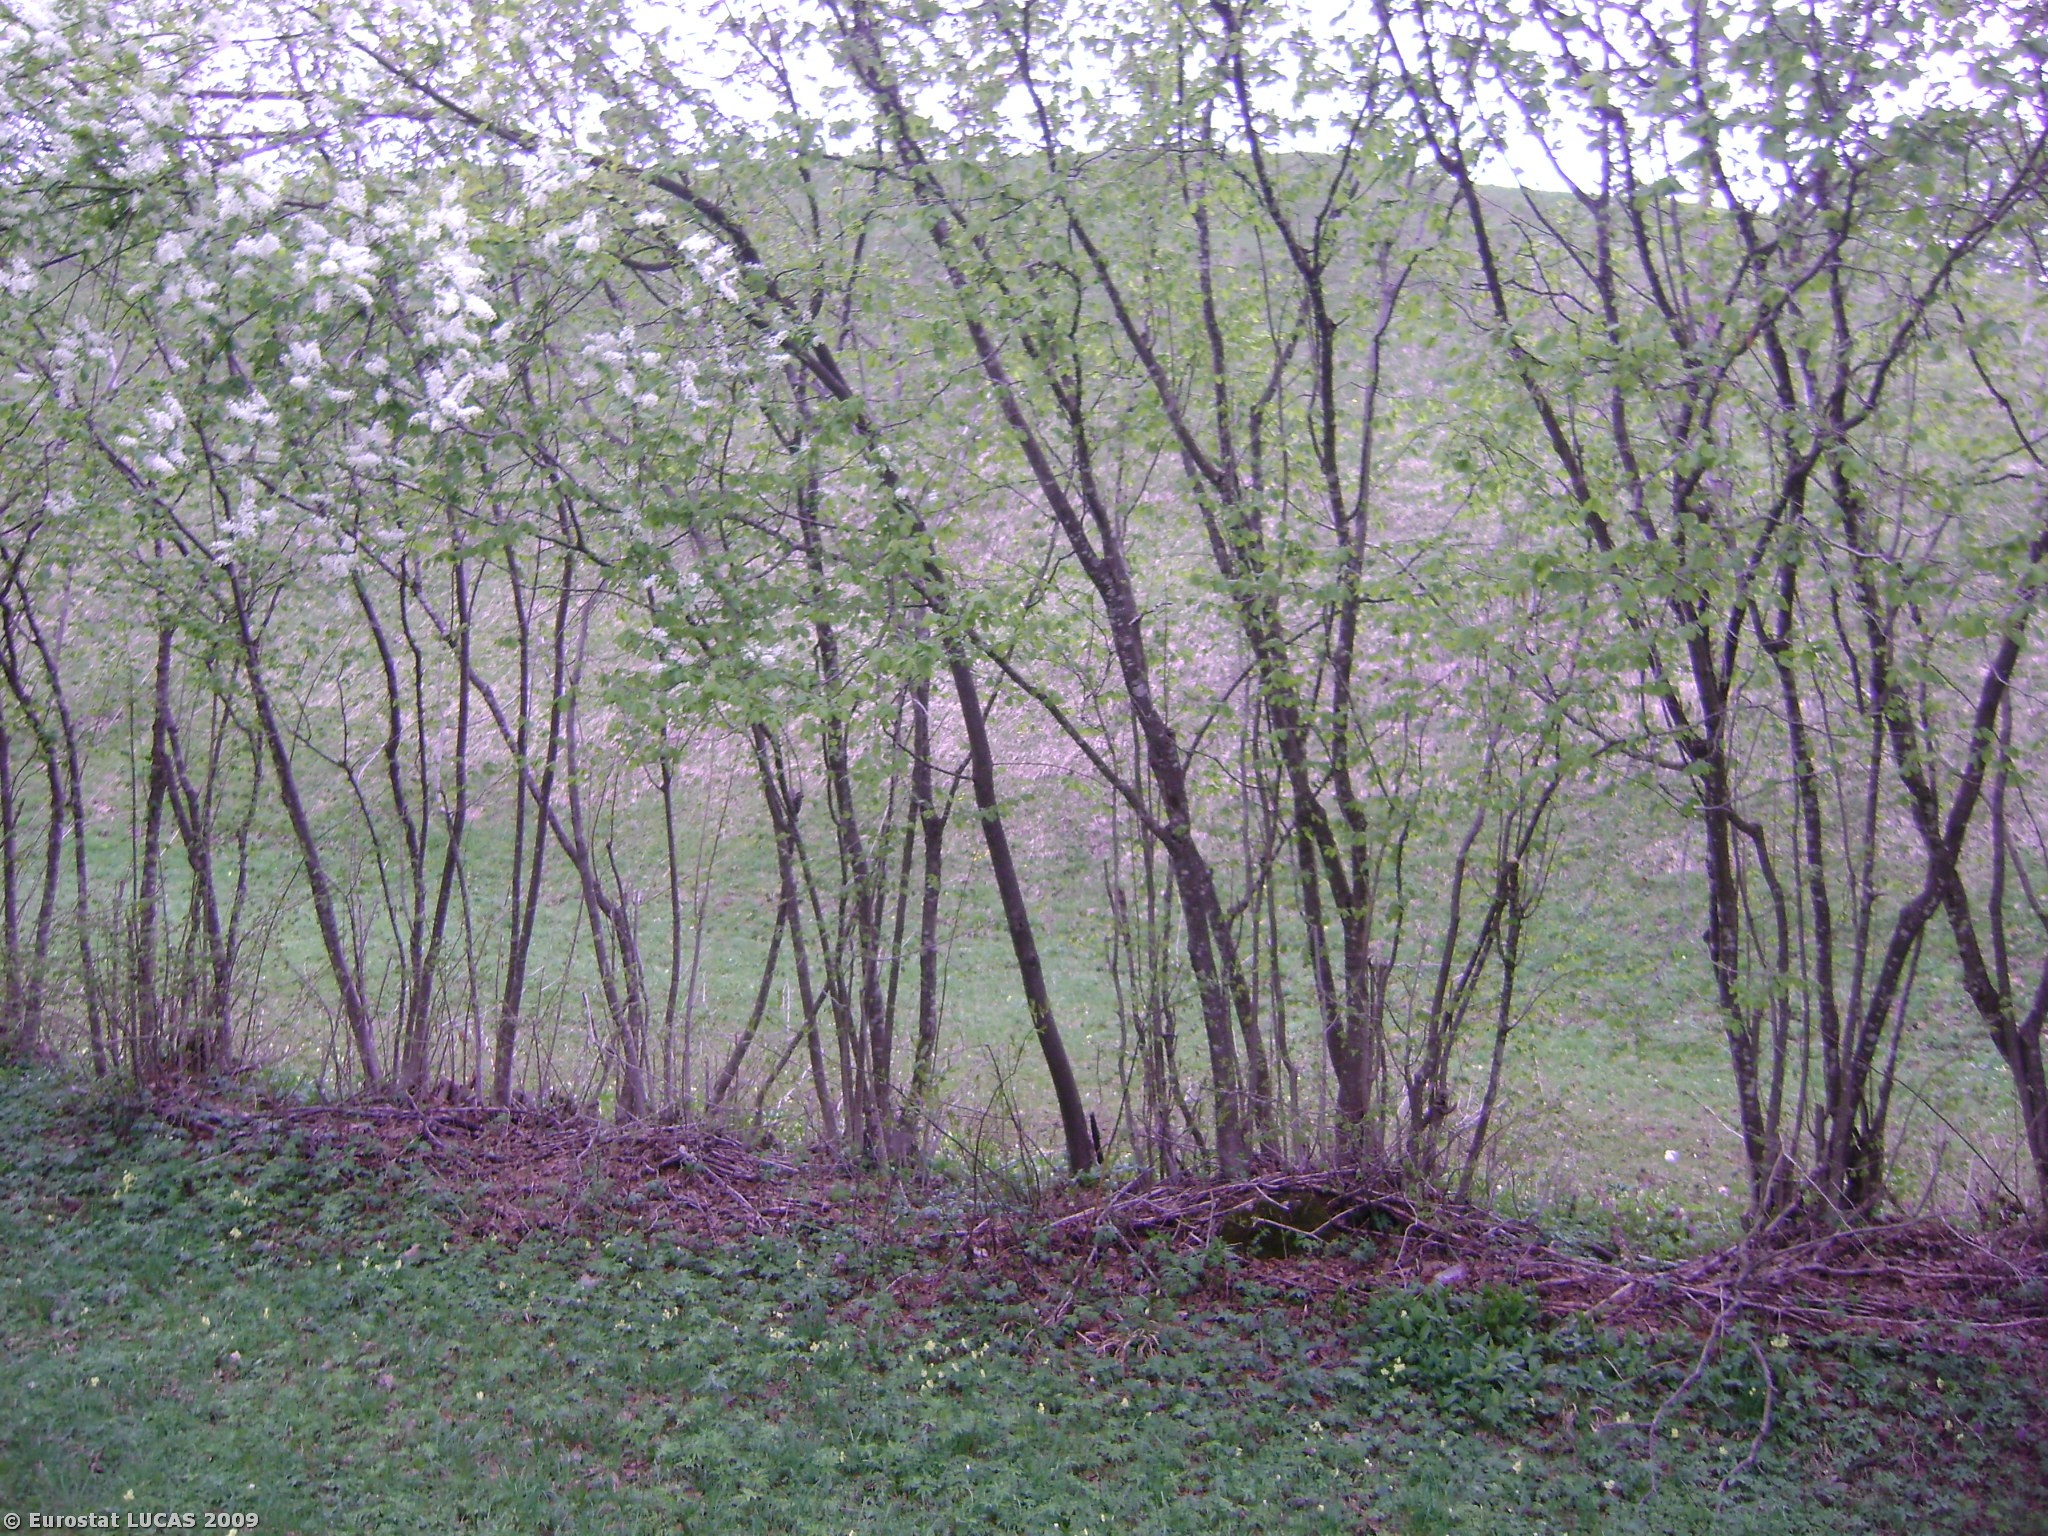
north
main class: Grassland
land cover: Grassland without tree/shrub cover
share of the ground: > 75 %
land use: Agriculture (excluding fallow land and kitchen gardens)
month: May
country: AT
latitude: 47.7625
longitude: 13.2140
